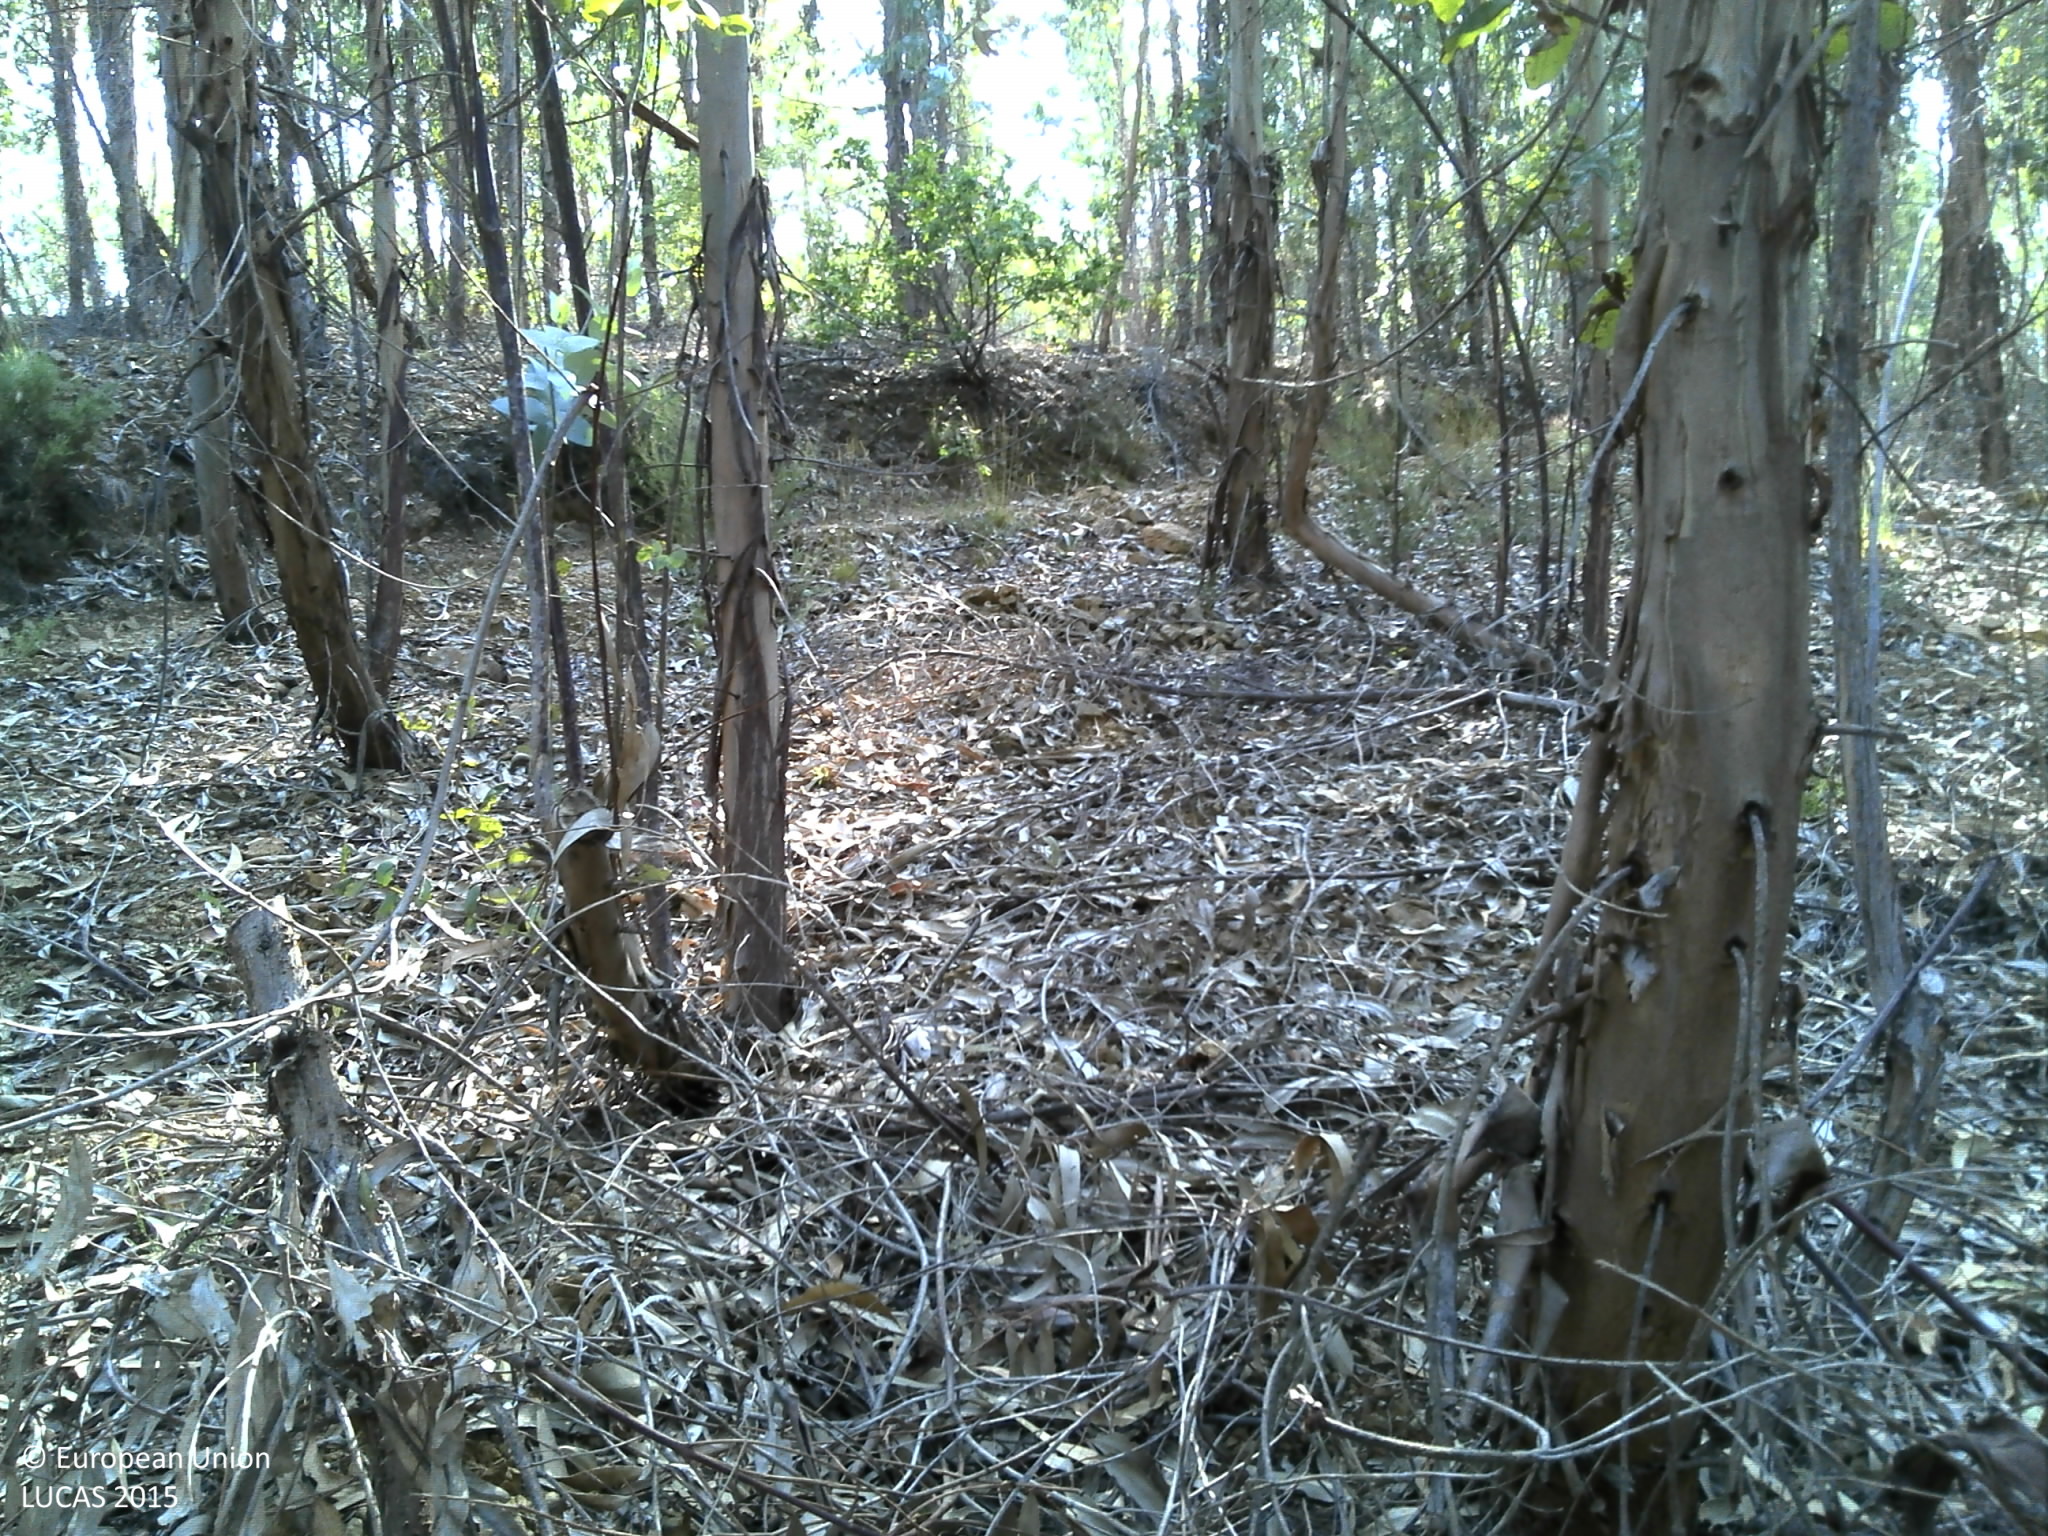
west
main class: Woodland
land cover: Broadleaved woodland
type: exotic forest
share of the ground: 25 - 50 %
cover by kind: unconsolidated bare surface 65 %, broadleaved forest trees 30 %, shrubs 5 %
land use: Forestry
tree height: > 5 m
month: June
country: PT
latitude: 39.9835
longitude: -8.1409
